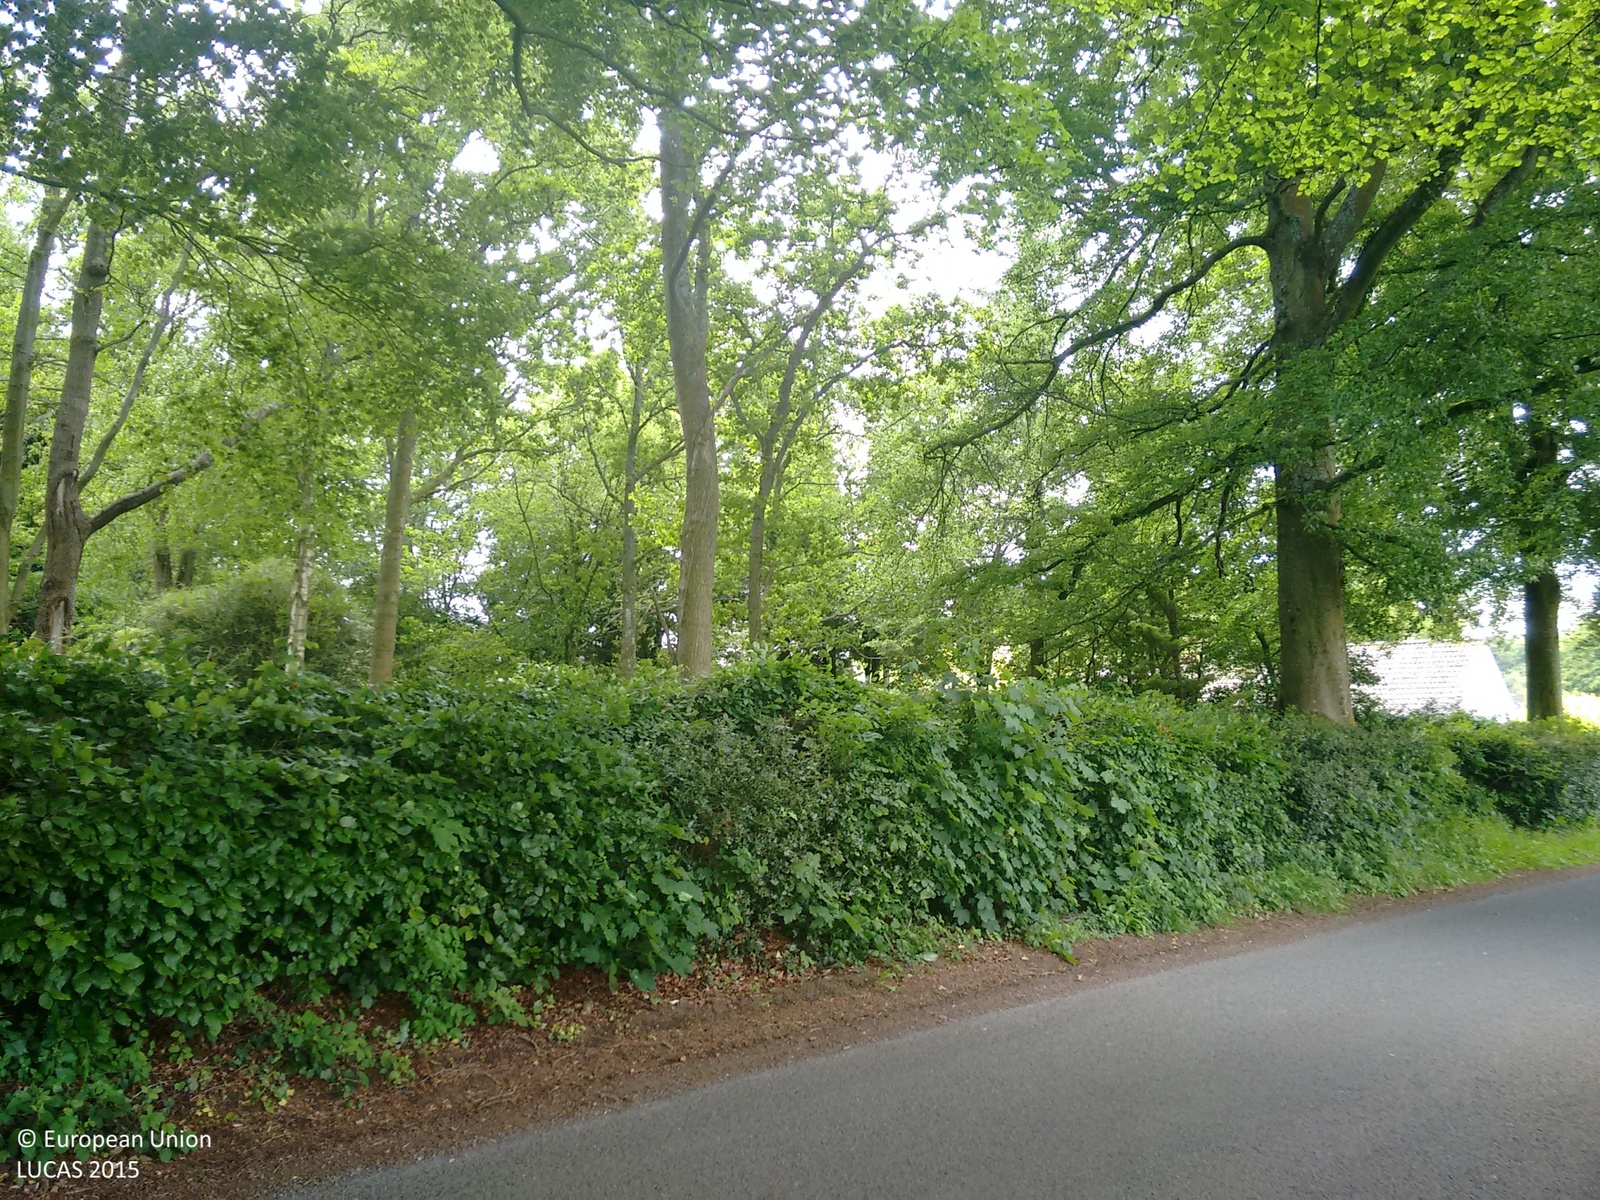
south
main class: Woodland
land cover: Broadleaved woodland
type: beech forest
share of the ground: > 75 %
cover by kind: broadleaved forest trees 90 %, herbaceous plants 10 %
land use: Semi-natural and natural areas not in use
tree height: > 5 m
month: June
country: GB
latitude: 51.1038
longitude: -3.2326
